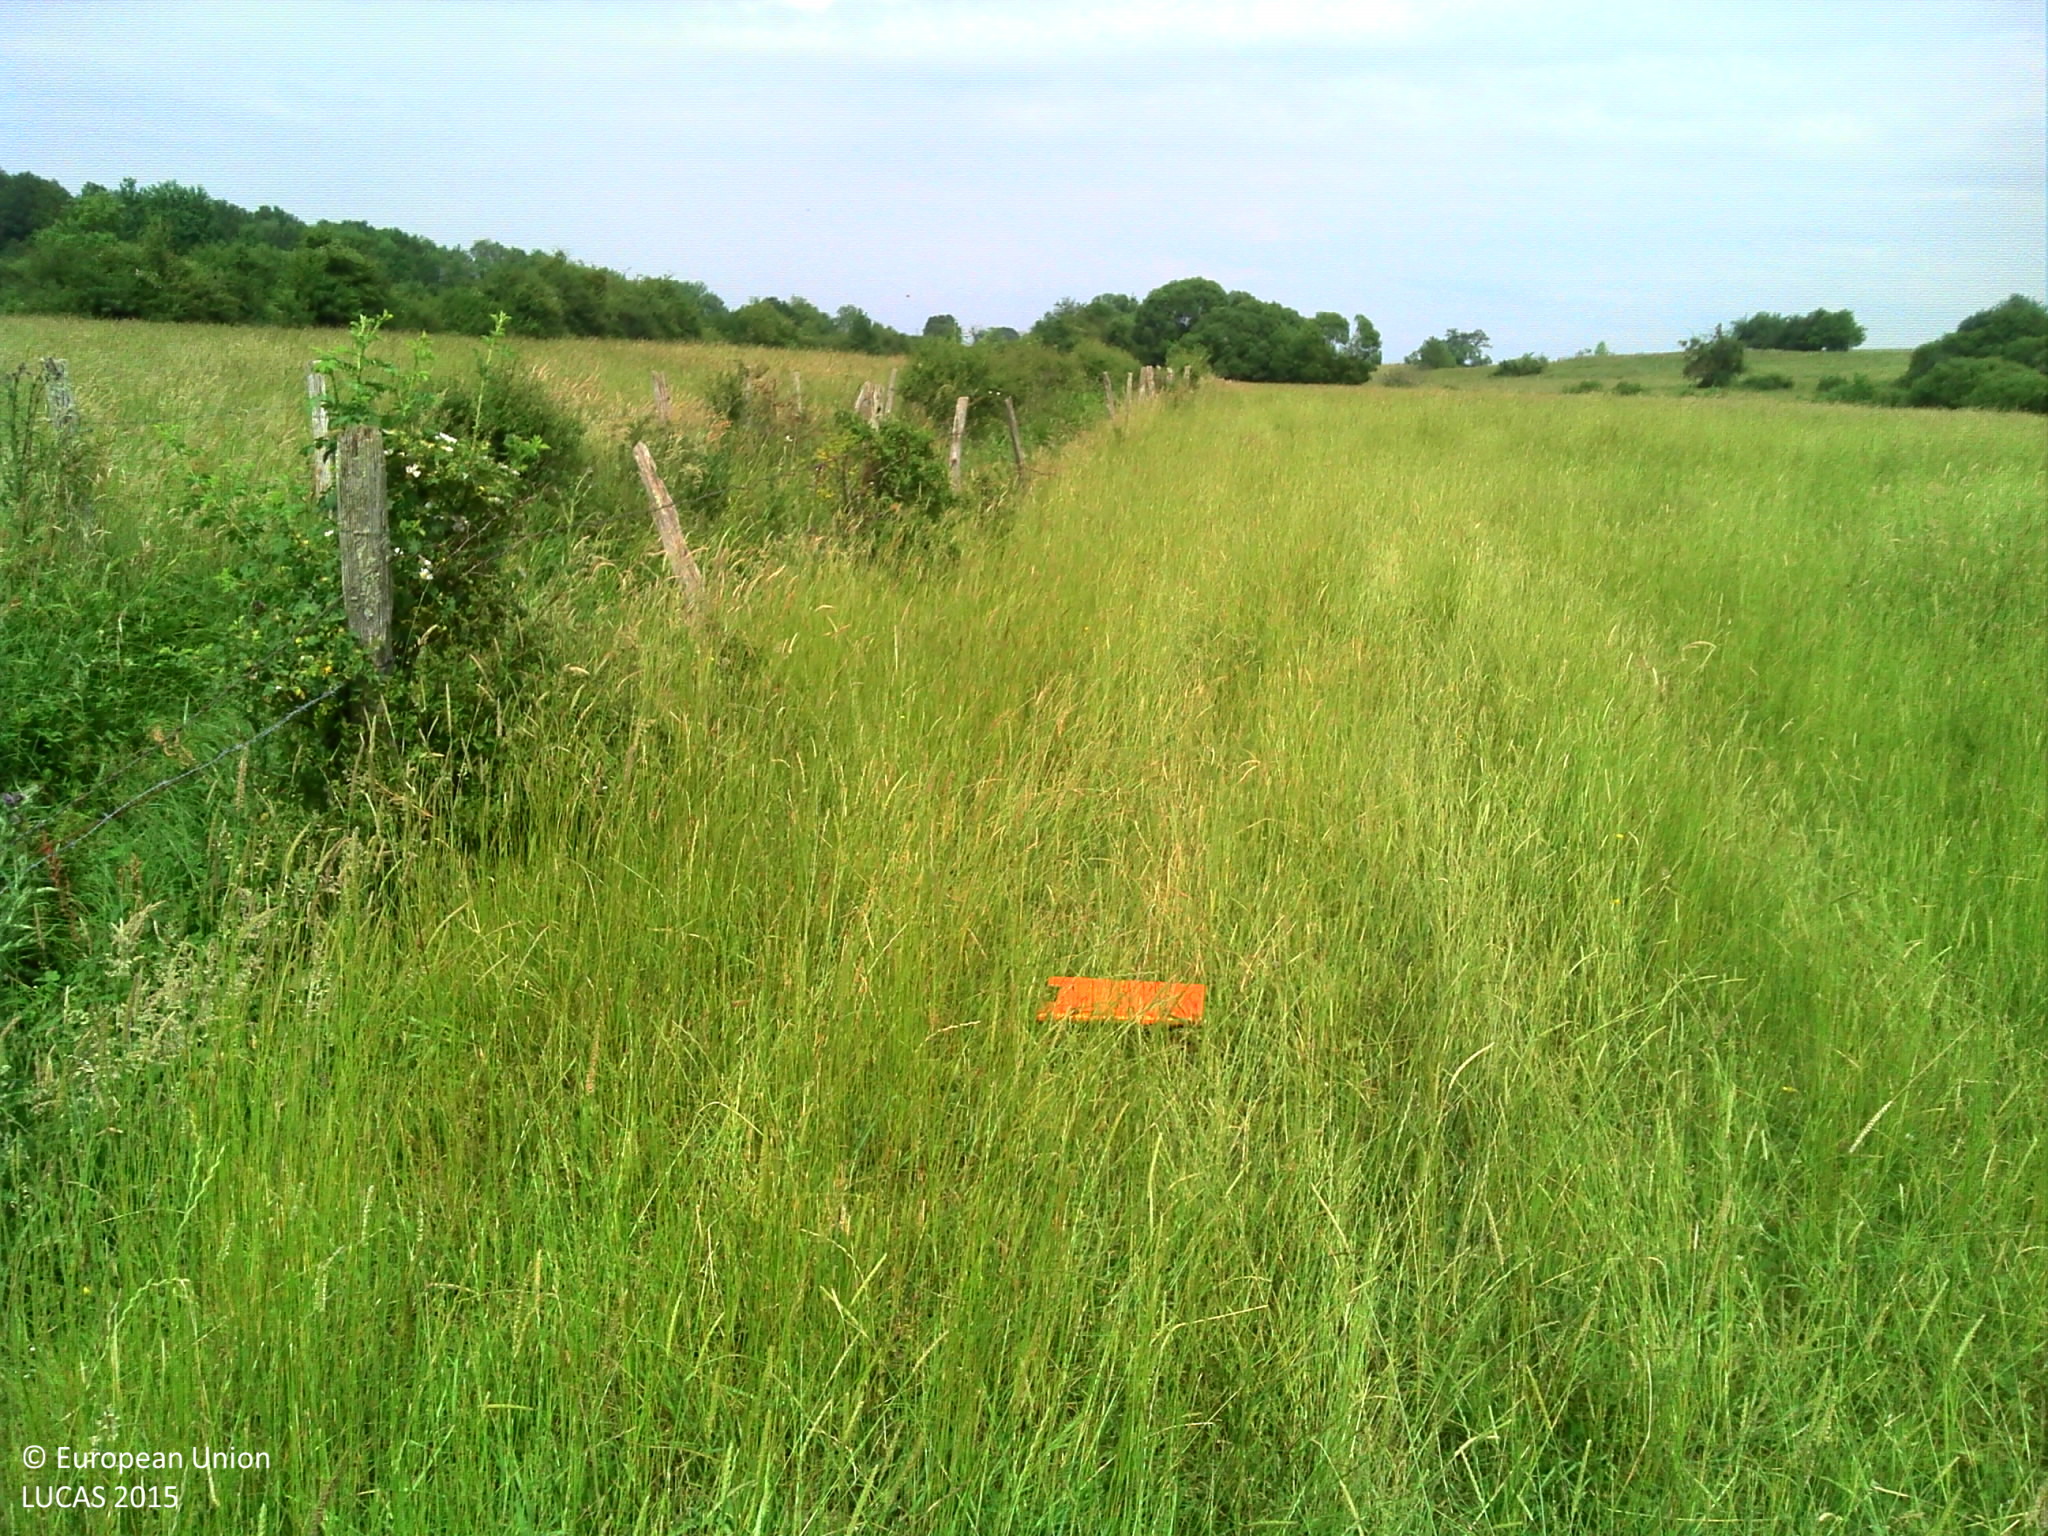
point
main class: Grassland
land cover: Grassland without tree/shrub cover
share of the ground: > 75 %
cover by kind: herbaceous plants 100 %
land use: Agriculture (excluding fallow land and kitchen gardens)
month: June
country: FR
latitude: 47.7806
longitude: 6.2241
